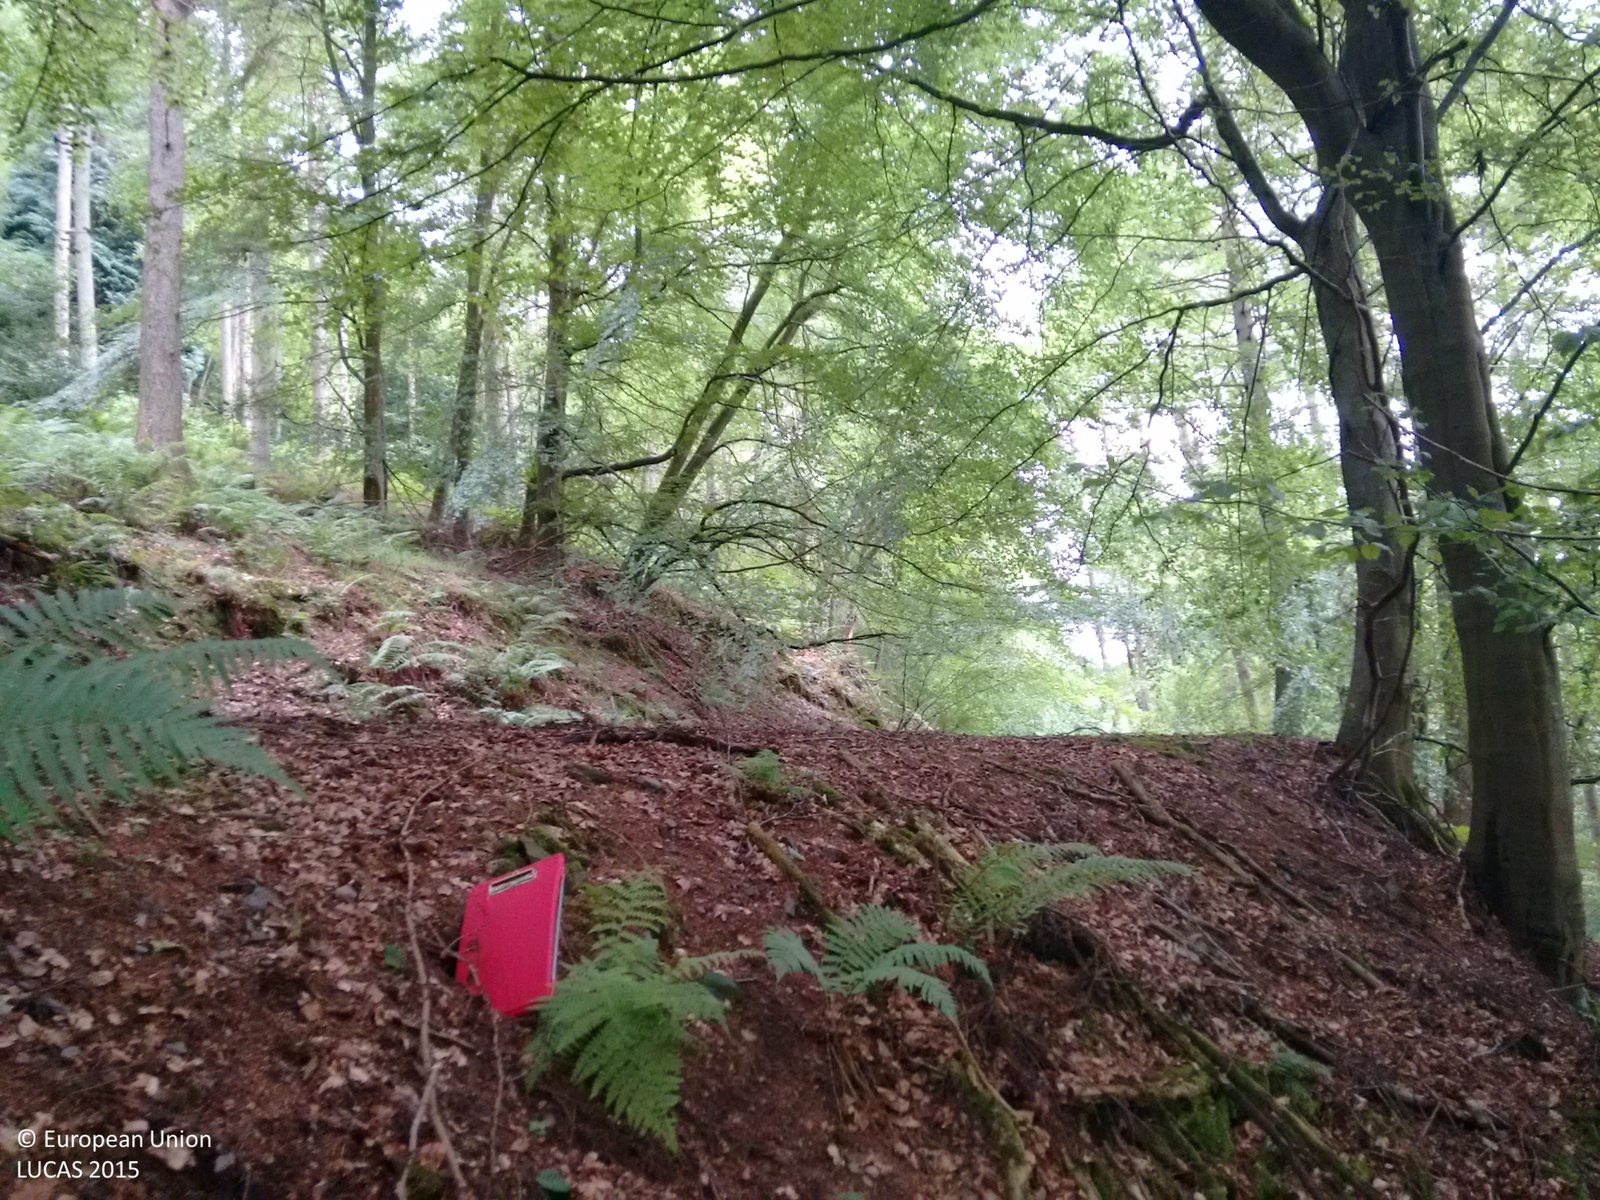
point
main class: Woodland
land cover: Broadleaved woodland
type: mesophytic deciduous forest
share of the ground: > 75 %
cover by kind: broadleaved forest trees 100 %
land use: Semi-natural and natural areas not in use
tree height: > 5 m
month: July
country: GB
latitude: 55.0338
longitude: -3.6487
